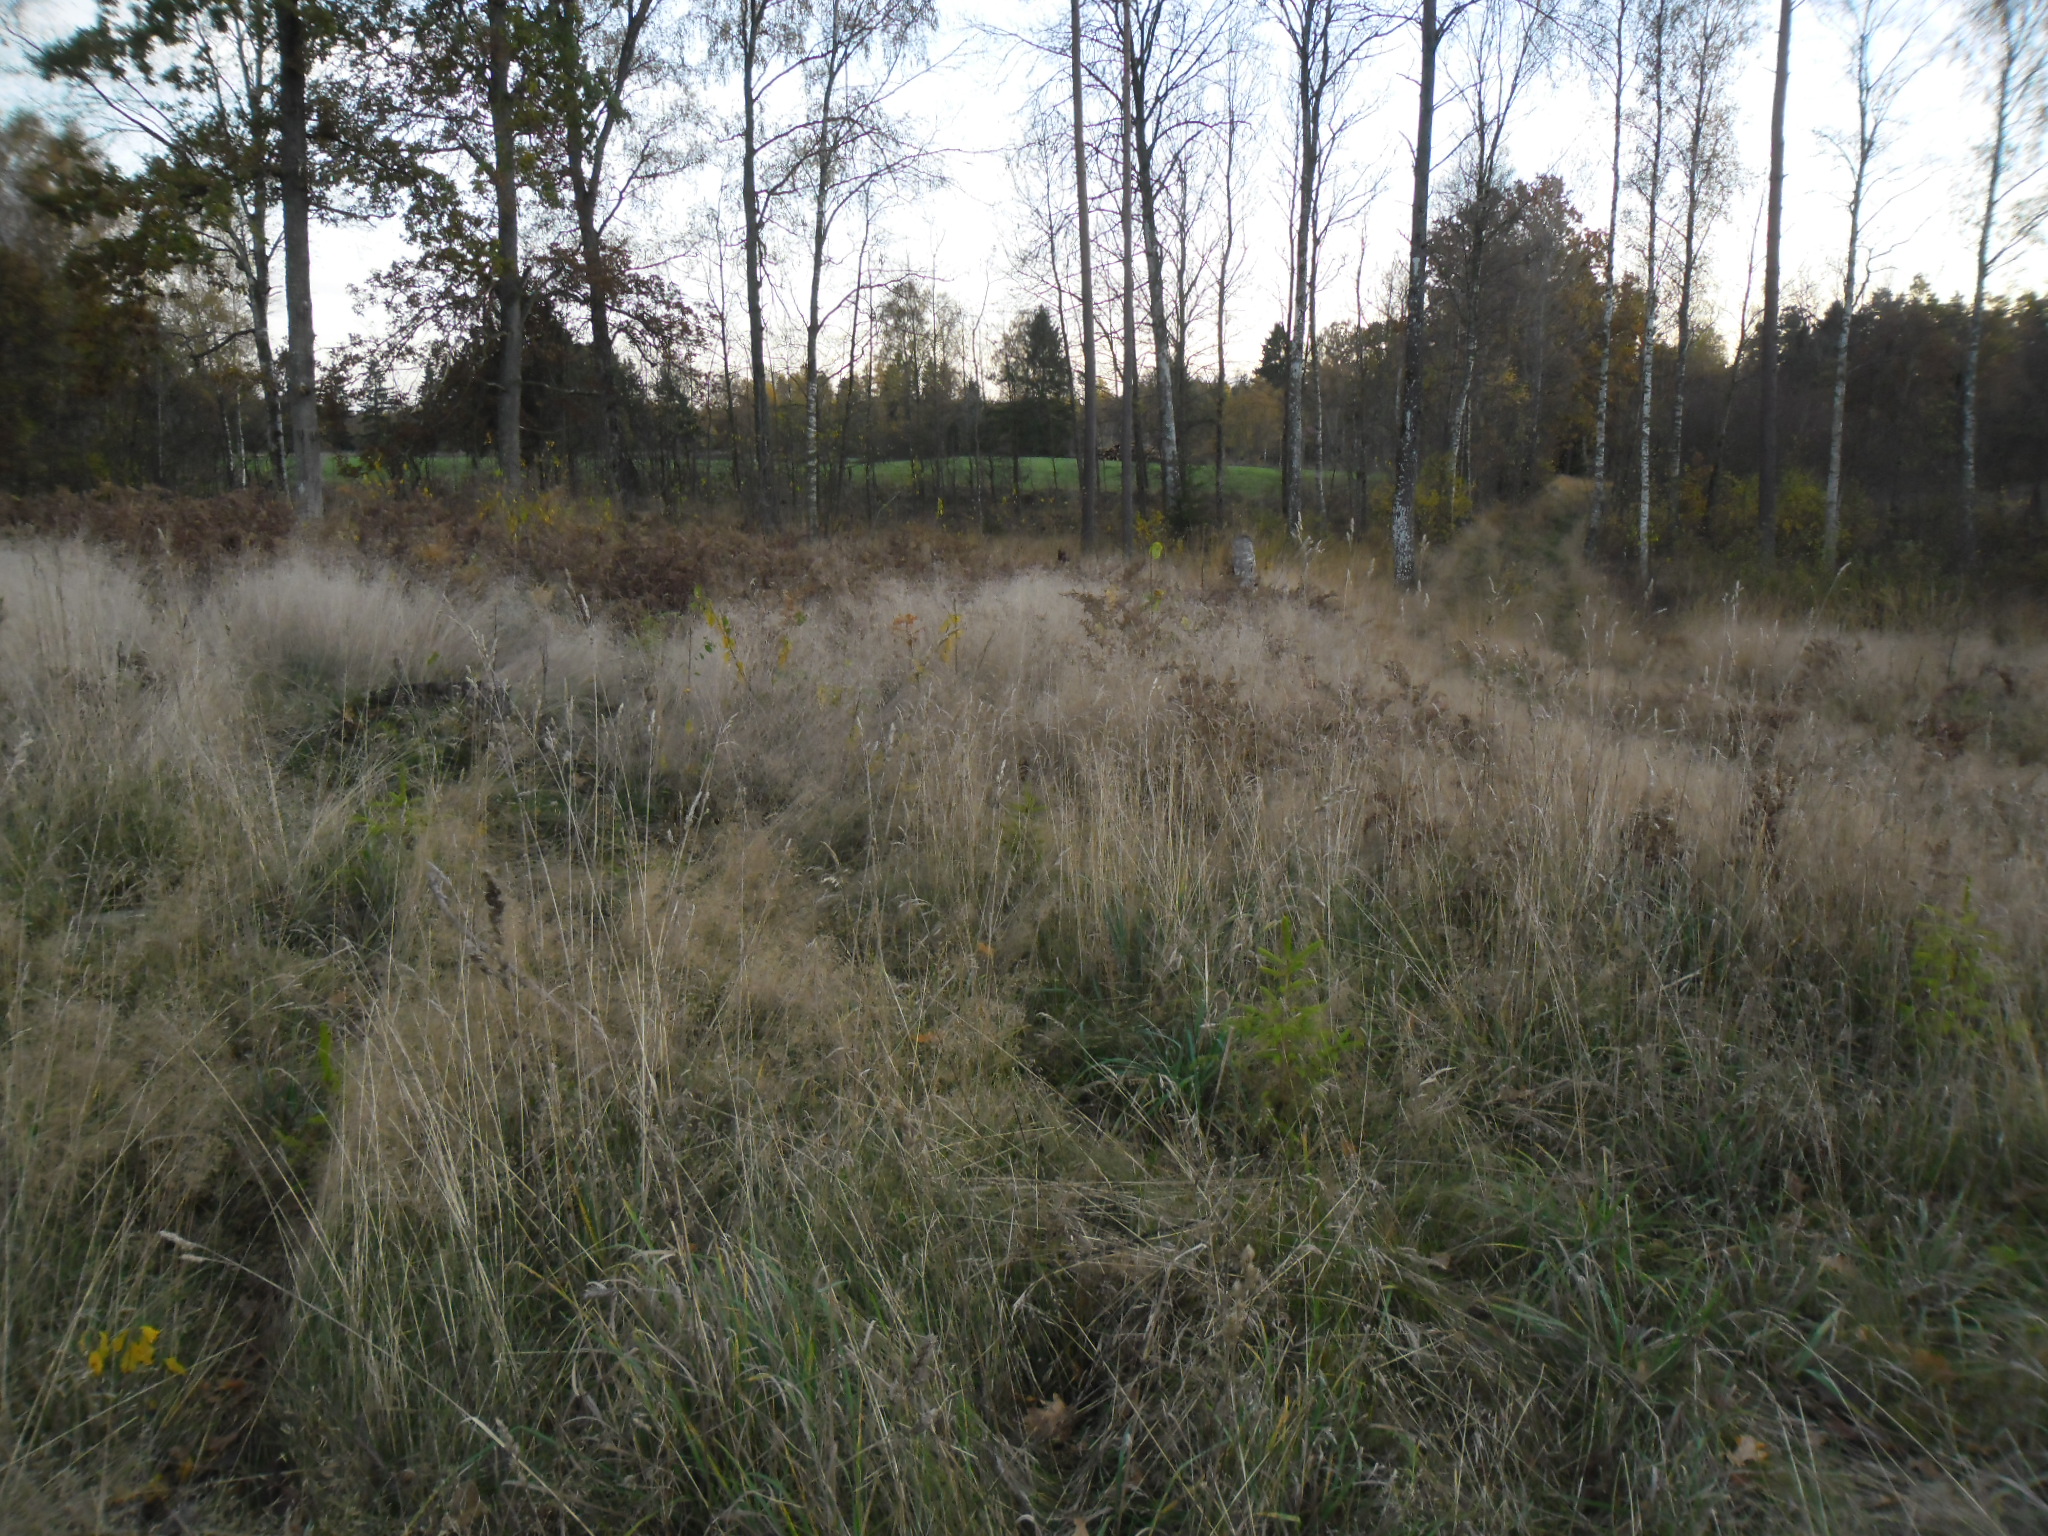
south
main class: Grassland
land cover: Grassland without tree/shrub cover
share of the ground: > 75 %
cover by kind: herbaceous plants 100 %
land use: Agriculture (excluding fallow land and kitchen gardens)
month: October
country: SE
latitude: 56.2229
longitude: 13.7552
